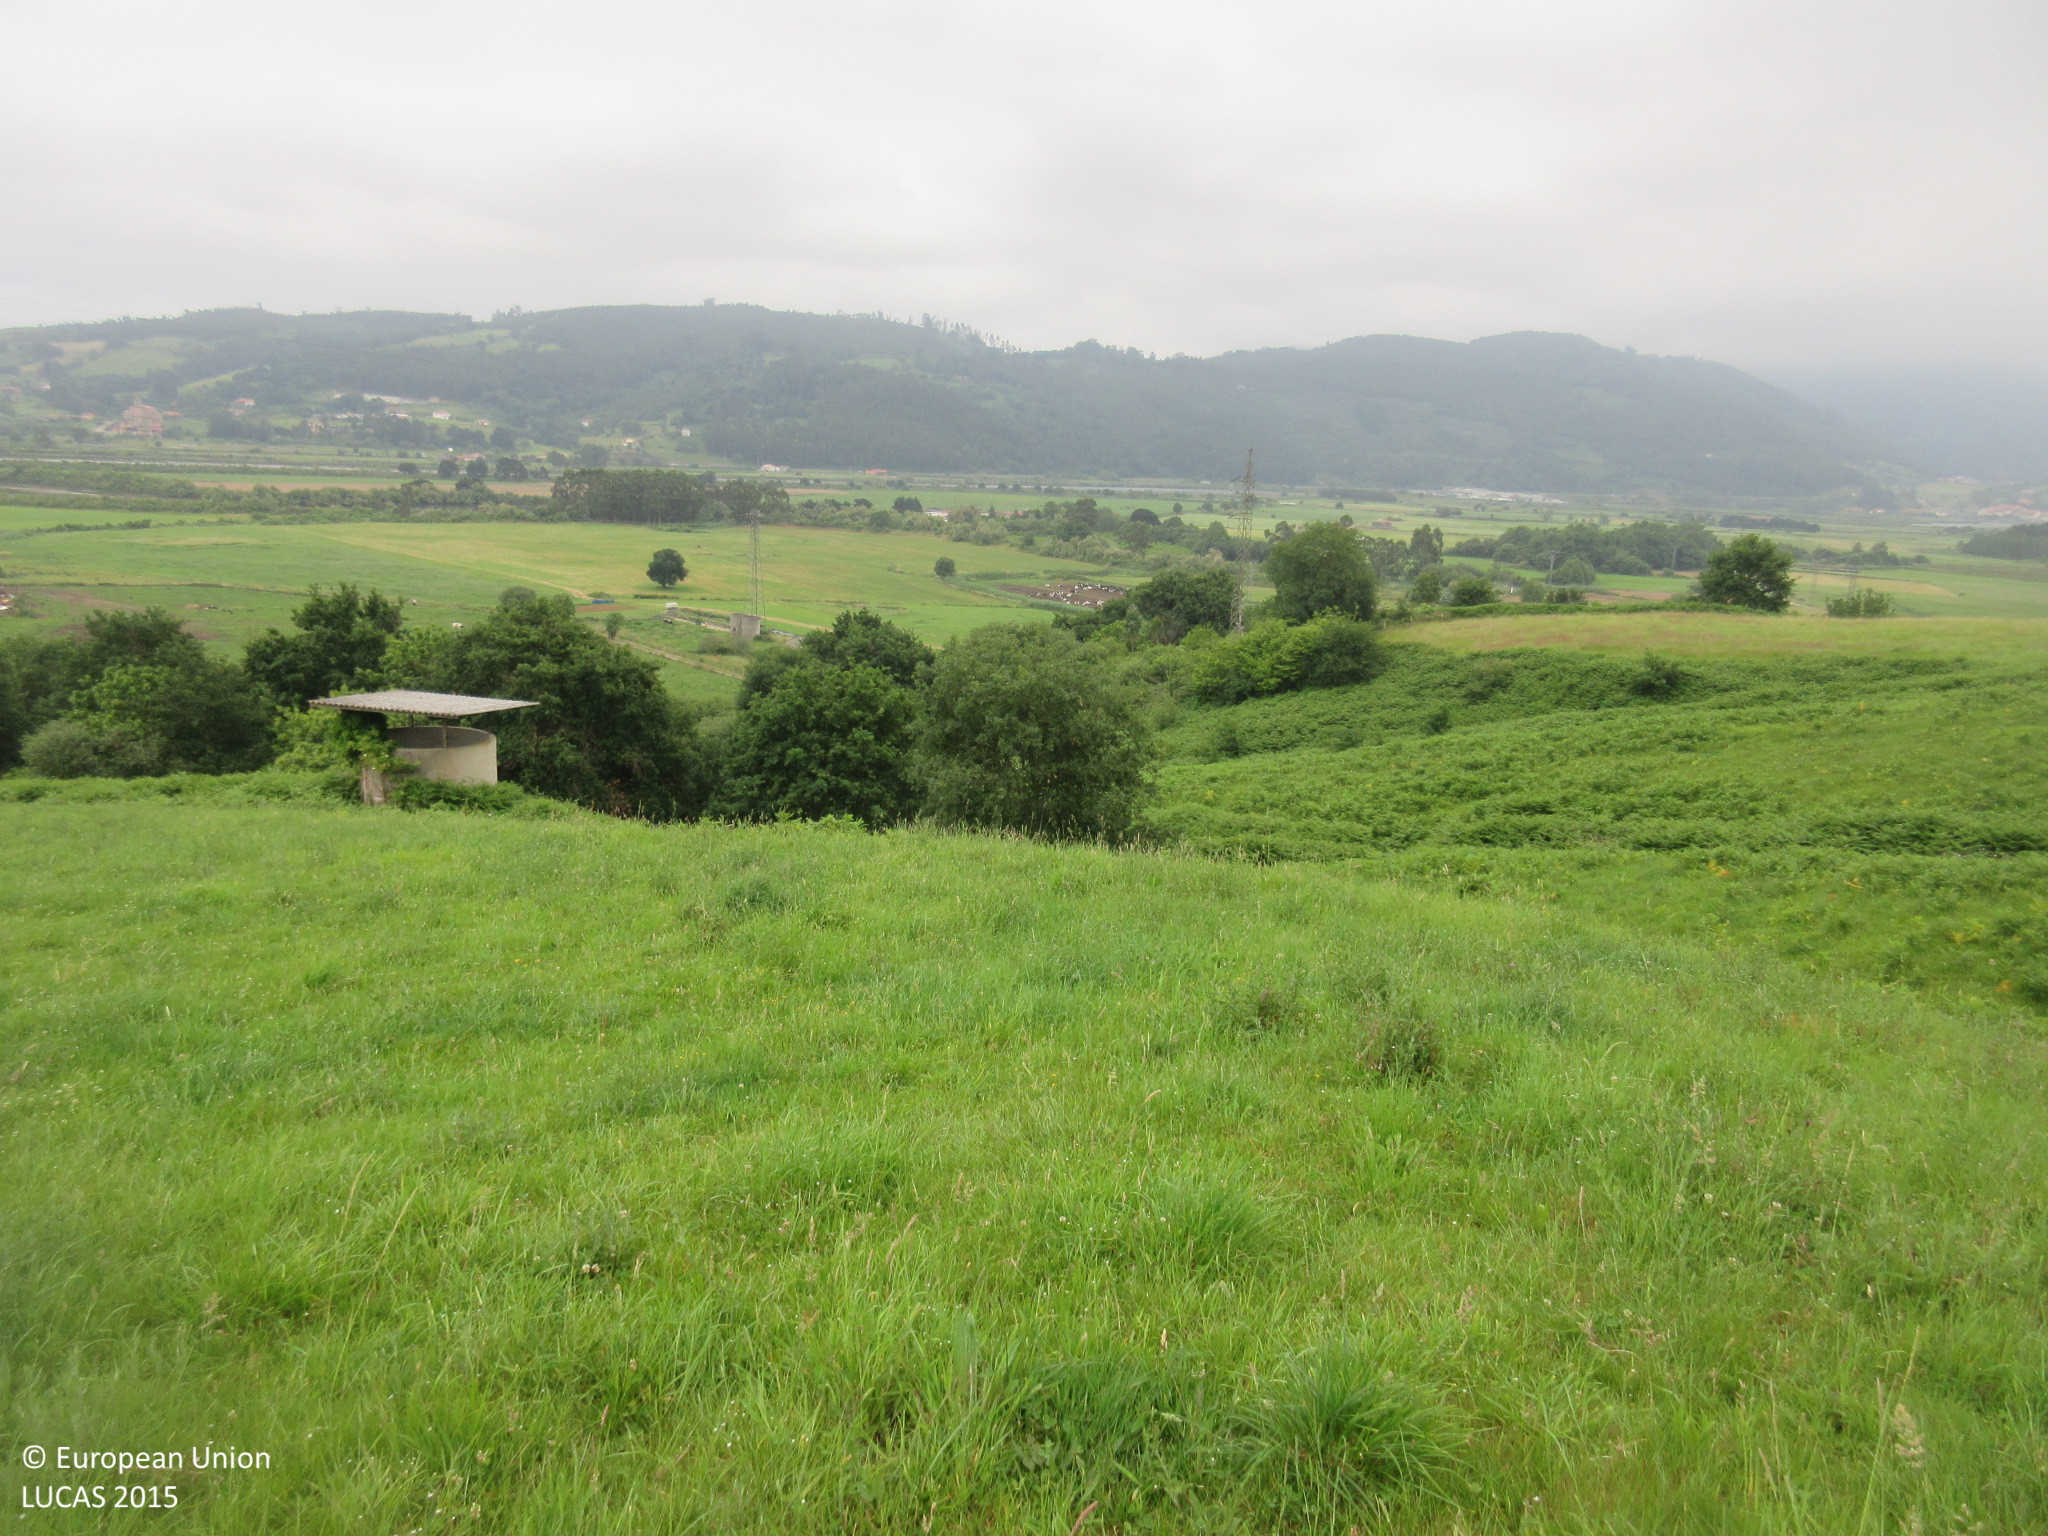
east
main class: Grassland
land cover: Grassland without tree/shrub cover
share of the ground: > 75 %
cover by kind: herbaceous plants 100 %
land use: Agriculture (excluding fallow land and kitchen gardens)
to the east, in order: Grassland without tree/shrub cover; Shrubland with sparse tree cover; Shrubland without tree cover; Broadleaved woodland; Electric lines; Broadleaved woodland; Grassland without tree/shrub cover; Railways; Grass margins; Tracks; Grassland without tree/shrub cover
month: June
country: ES
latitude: 43.3778
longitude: -3.4593
